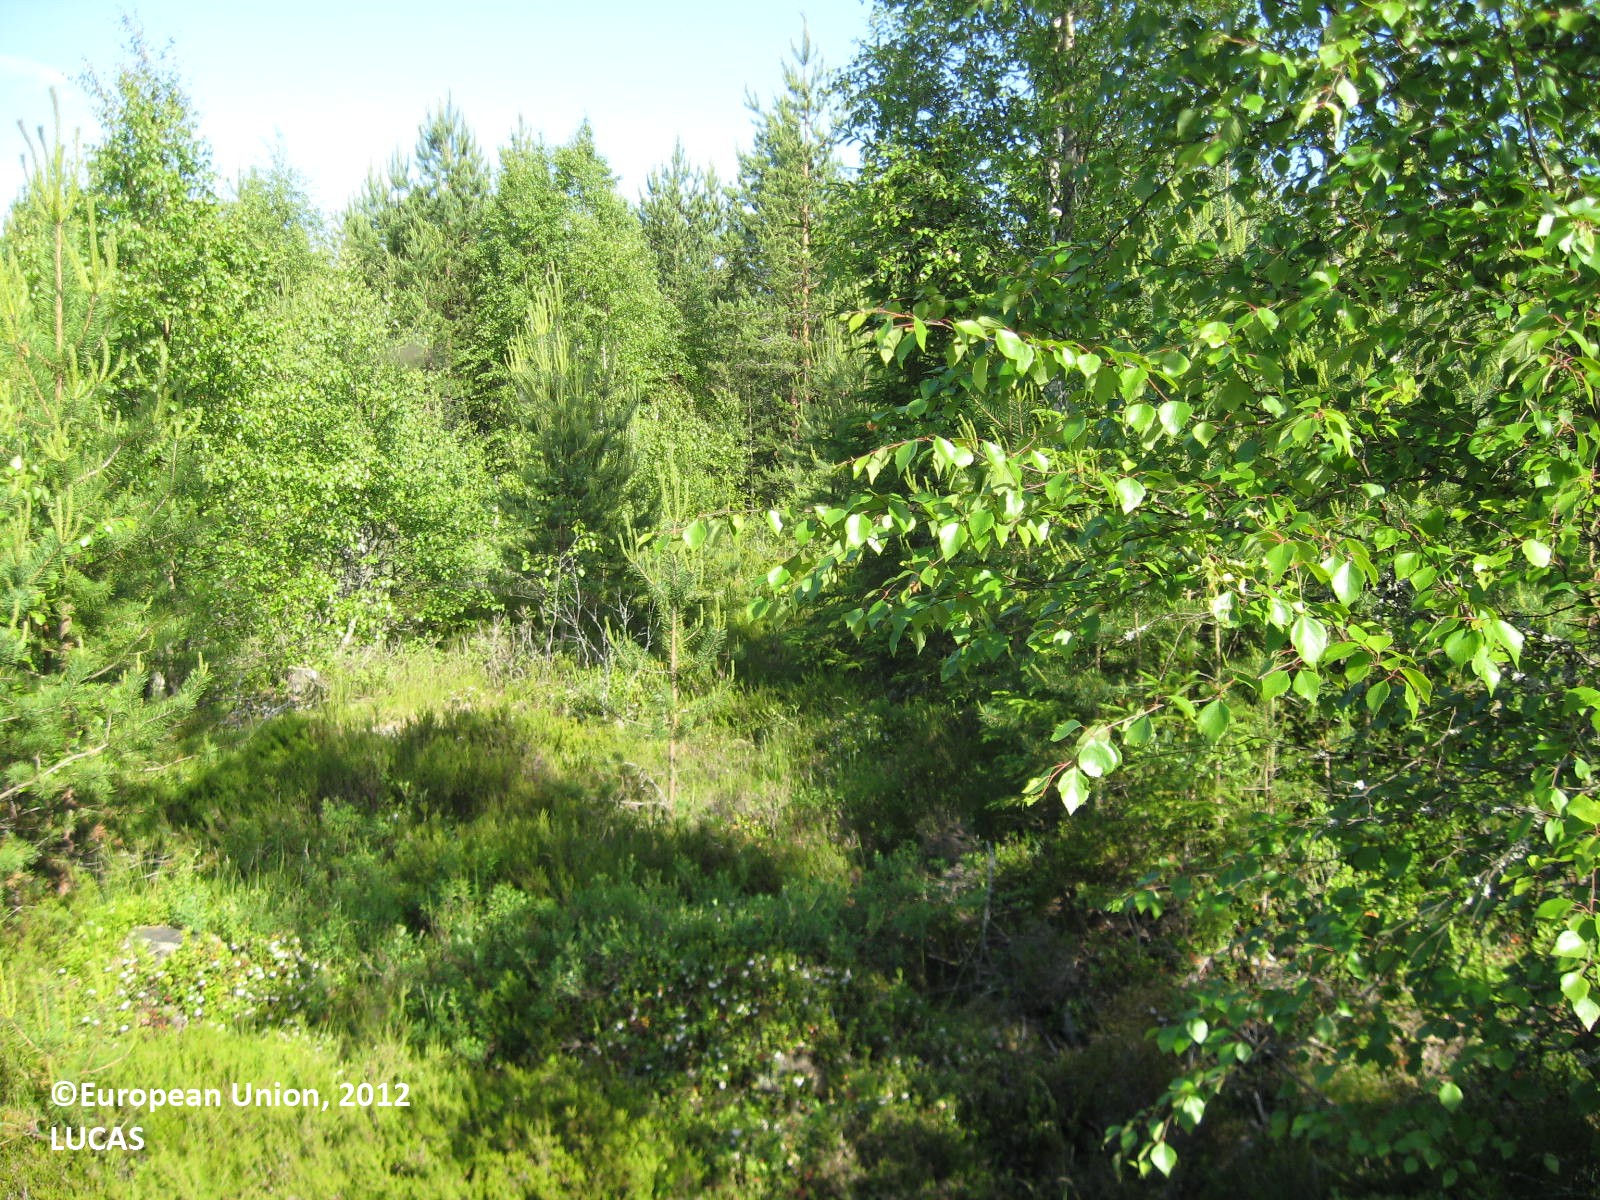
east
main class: Woodland
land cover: Other mixed woodland
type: boreal forest
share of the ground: > 75 %
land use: Forestry
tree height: < 5 m
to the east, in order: Other mixed woodland; Ditches and canals; Pine dominated coniferous woodland; Pine dominated mixed woodland; Ditches and canals; Pine dominated mixed woodland; Ditches and canals; Pine dominated mixed woodland; Ditches and canals; Pine dominated mixed woodland
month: June
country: FI
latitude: 62.6247
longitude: 21.7612
